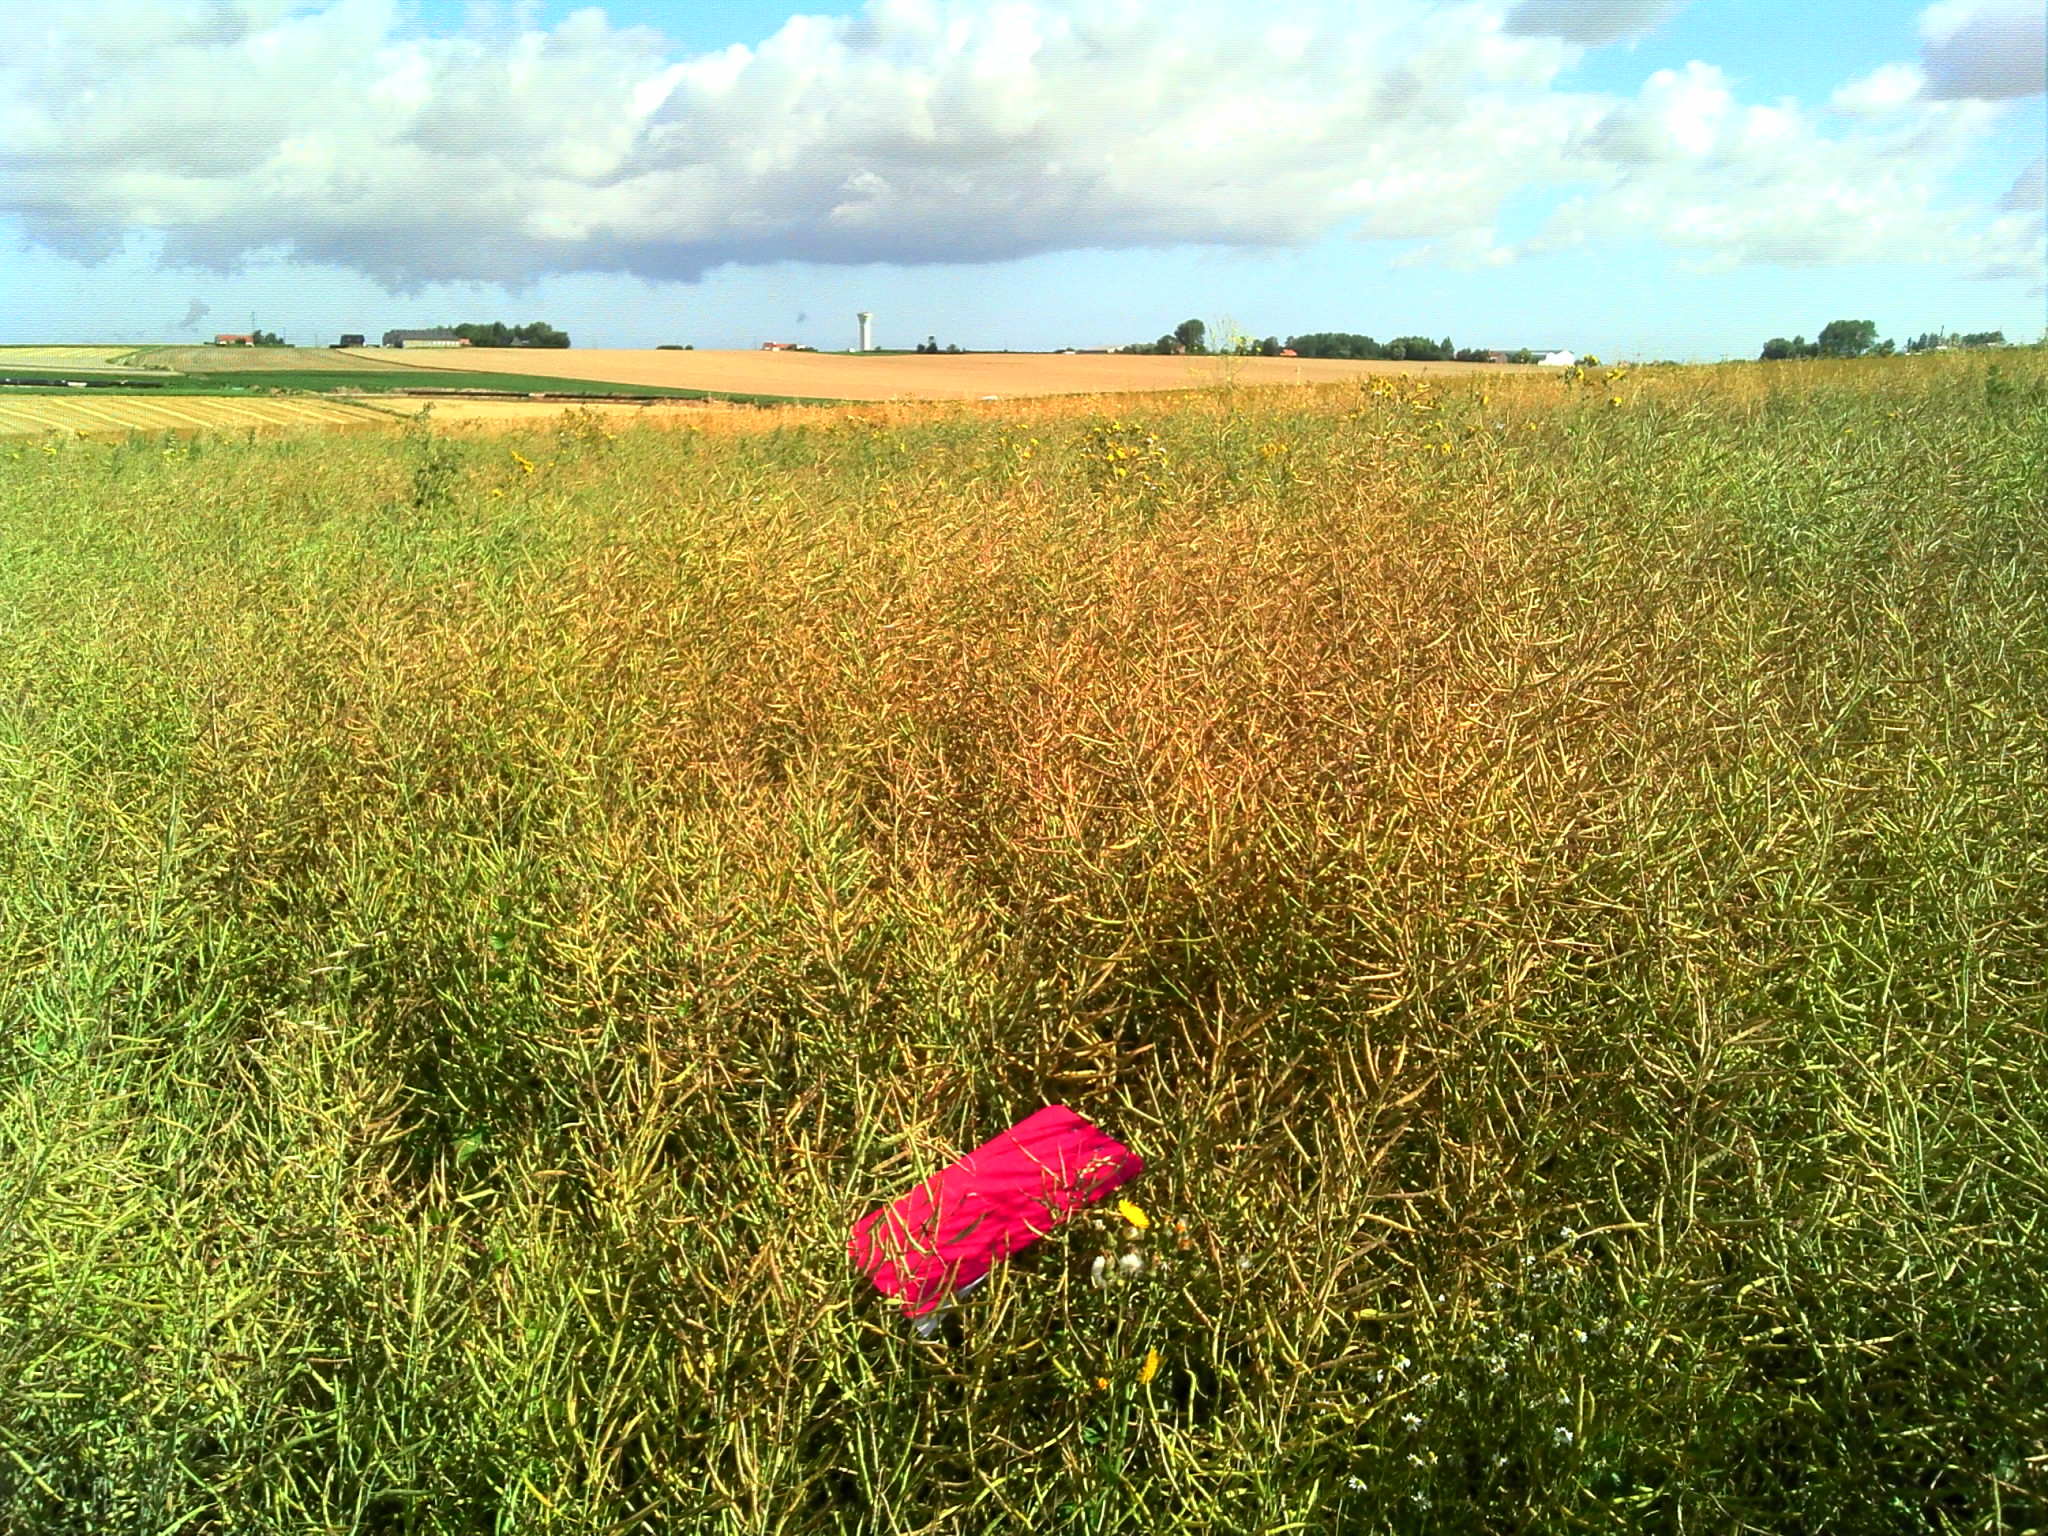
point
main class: Cropland
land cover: Rape and turnip rape
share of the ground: > 75 %
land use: Agriculture (excluding fallow land and kitchen gardens)
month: July
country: FR
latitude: 50.9203
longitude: 2.3473
